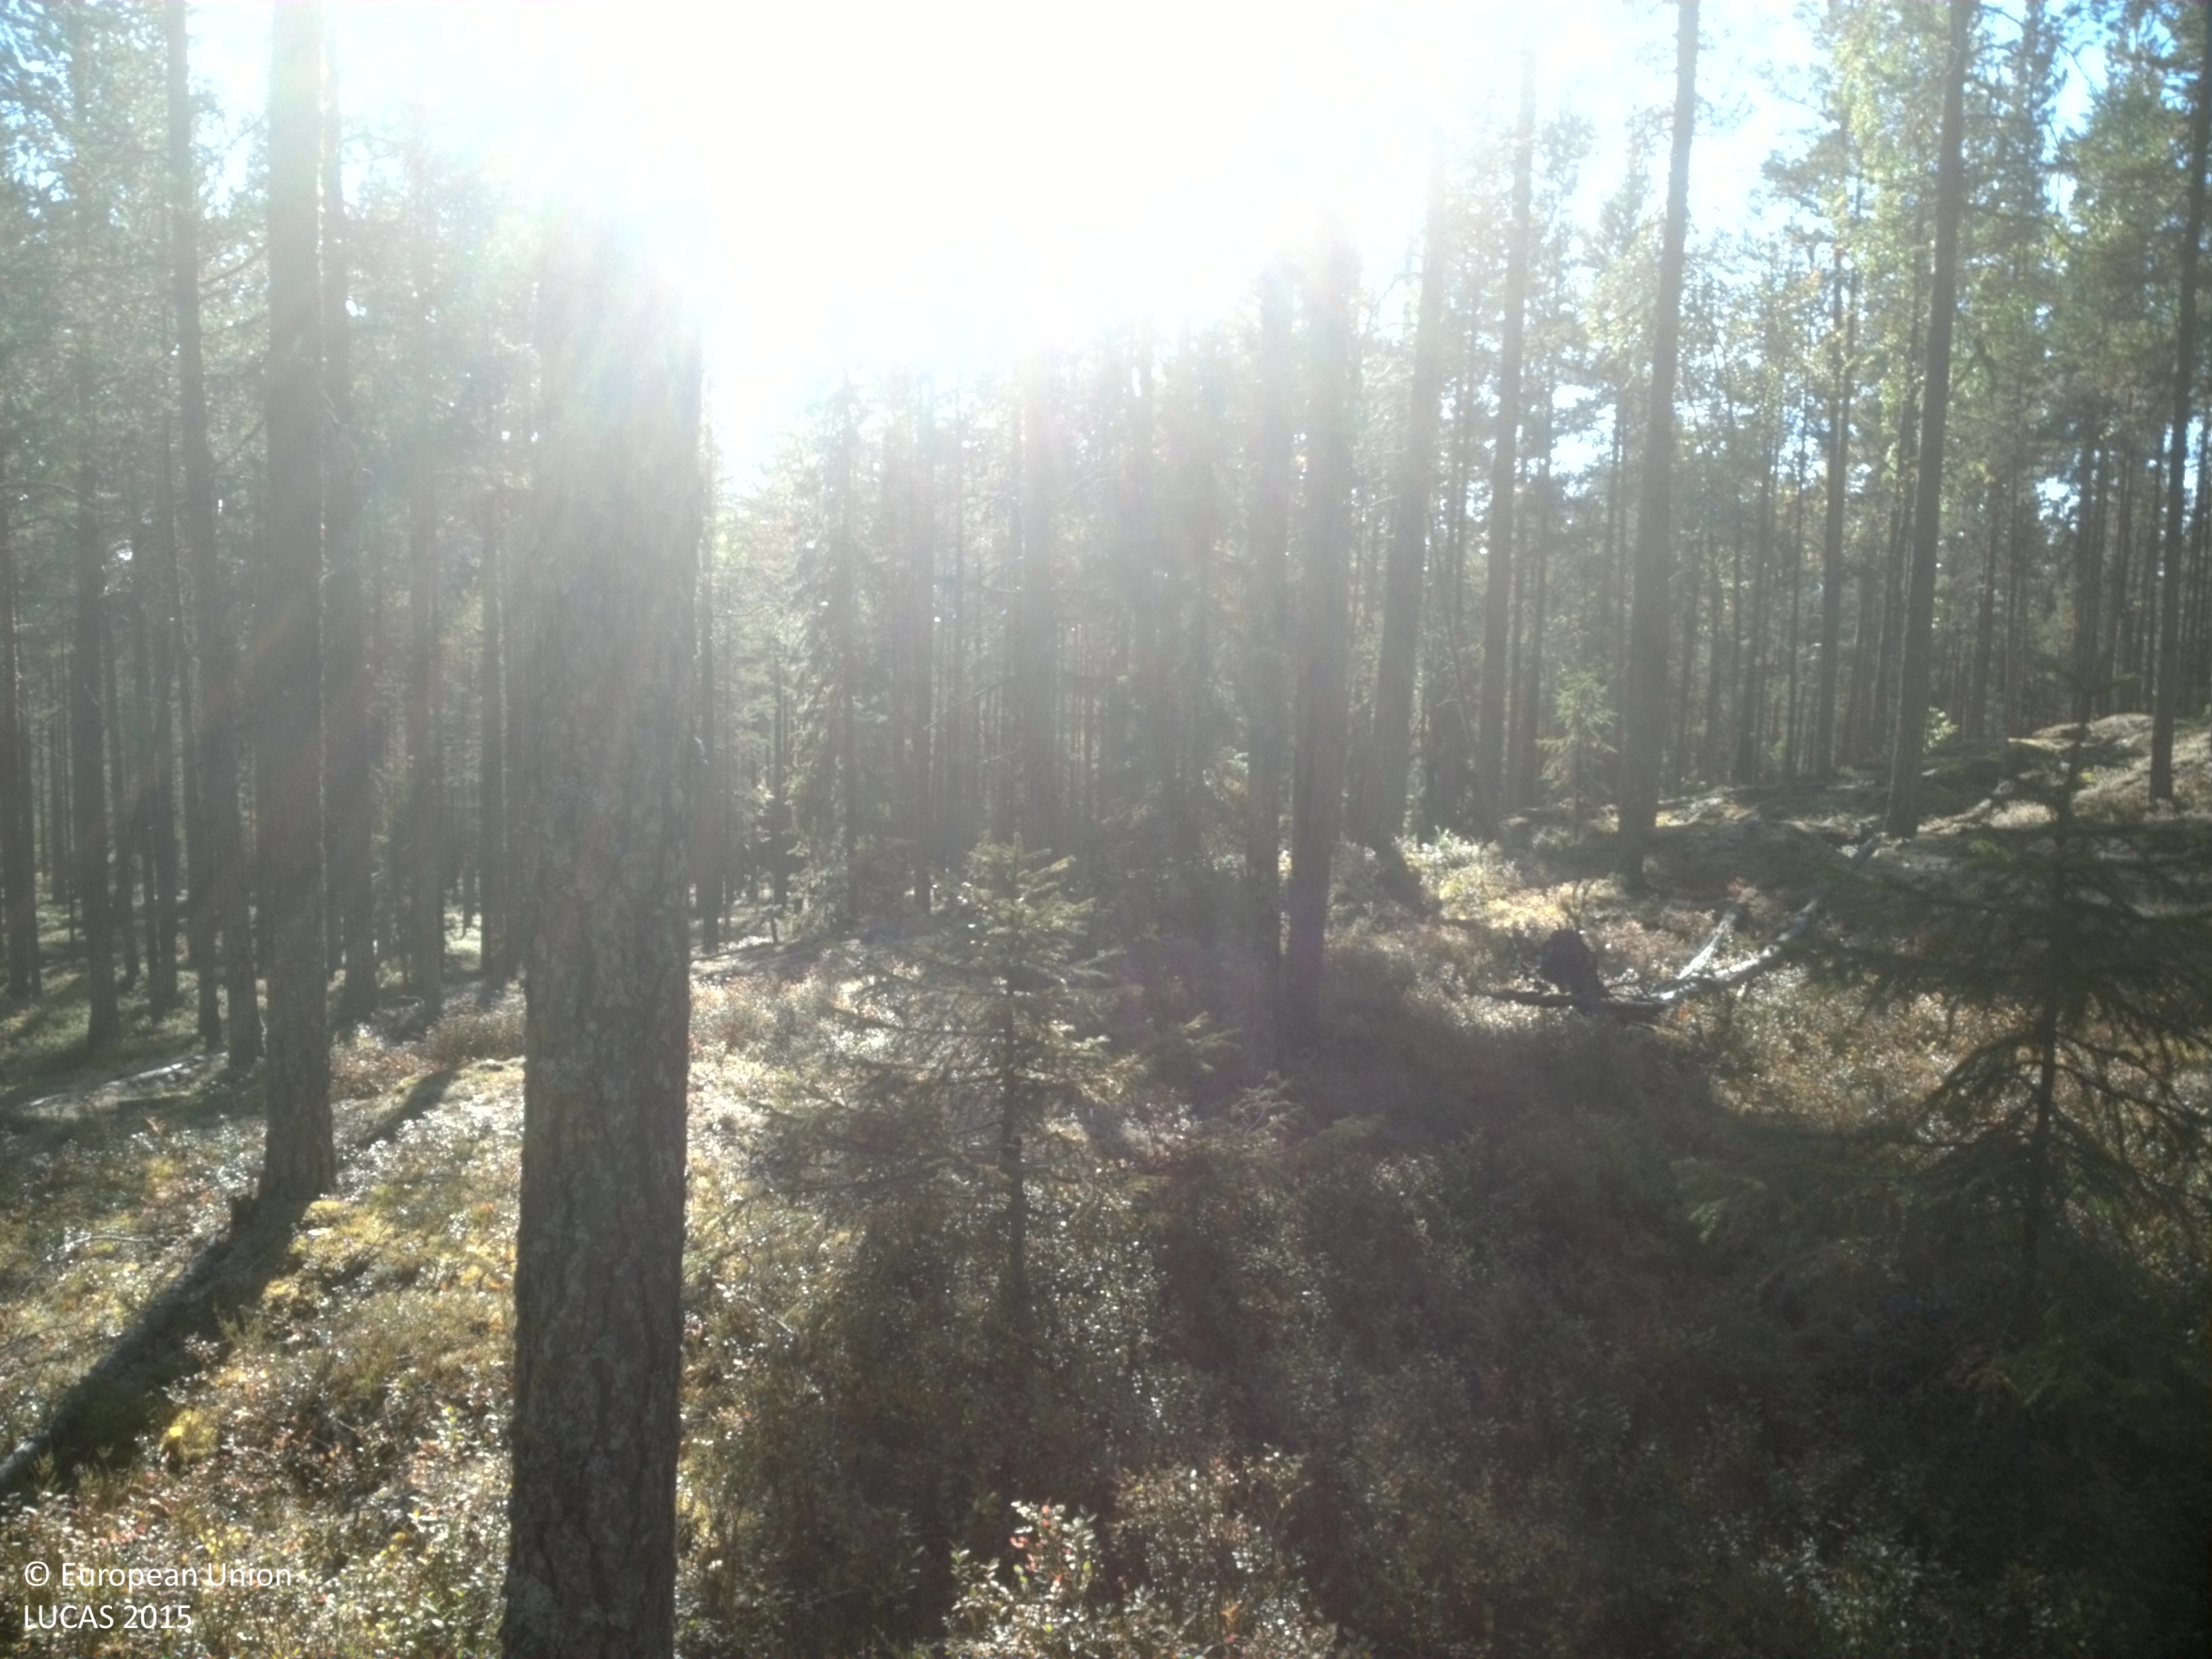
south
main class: Woodland
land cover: Pine dominated coniferous woodland
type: boreal forest
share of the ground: 50 - 75 %
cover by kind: coniferous forest trees 55 %, shrubs 35 %, lichens and mosses 5 %, consolidated bare surface 5 %
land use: Forestry
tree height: > 5 m
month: September
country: SE
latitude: 64.2470
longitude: 19.6906
